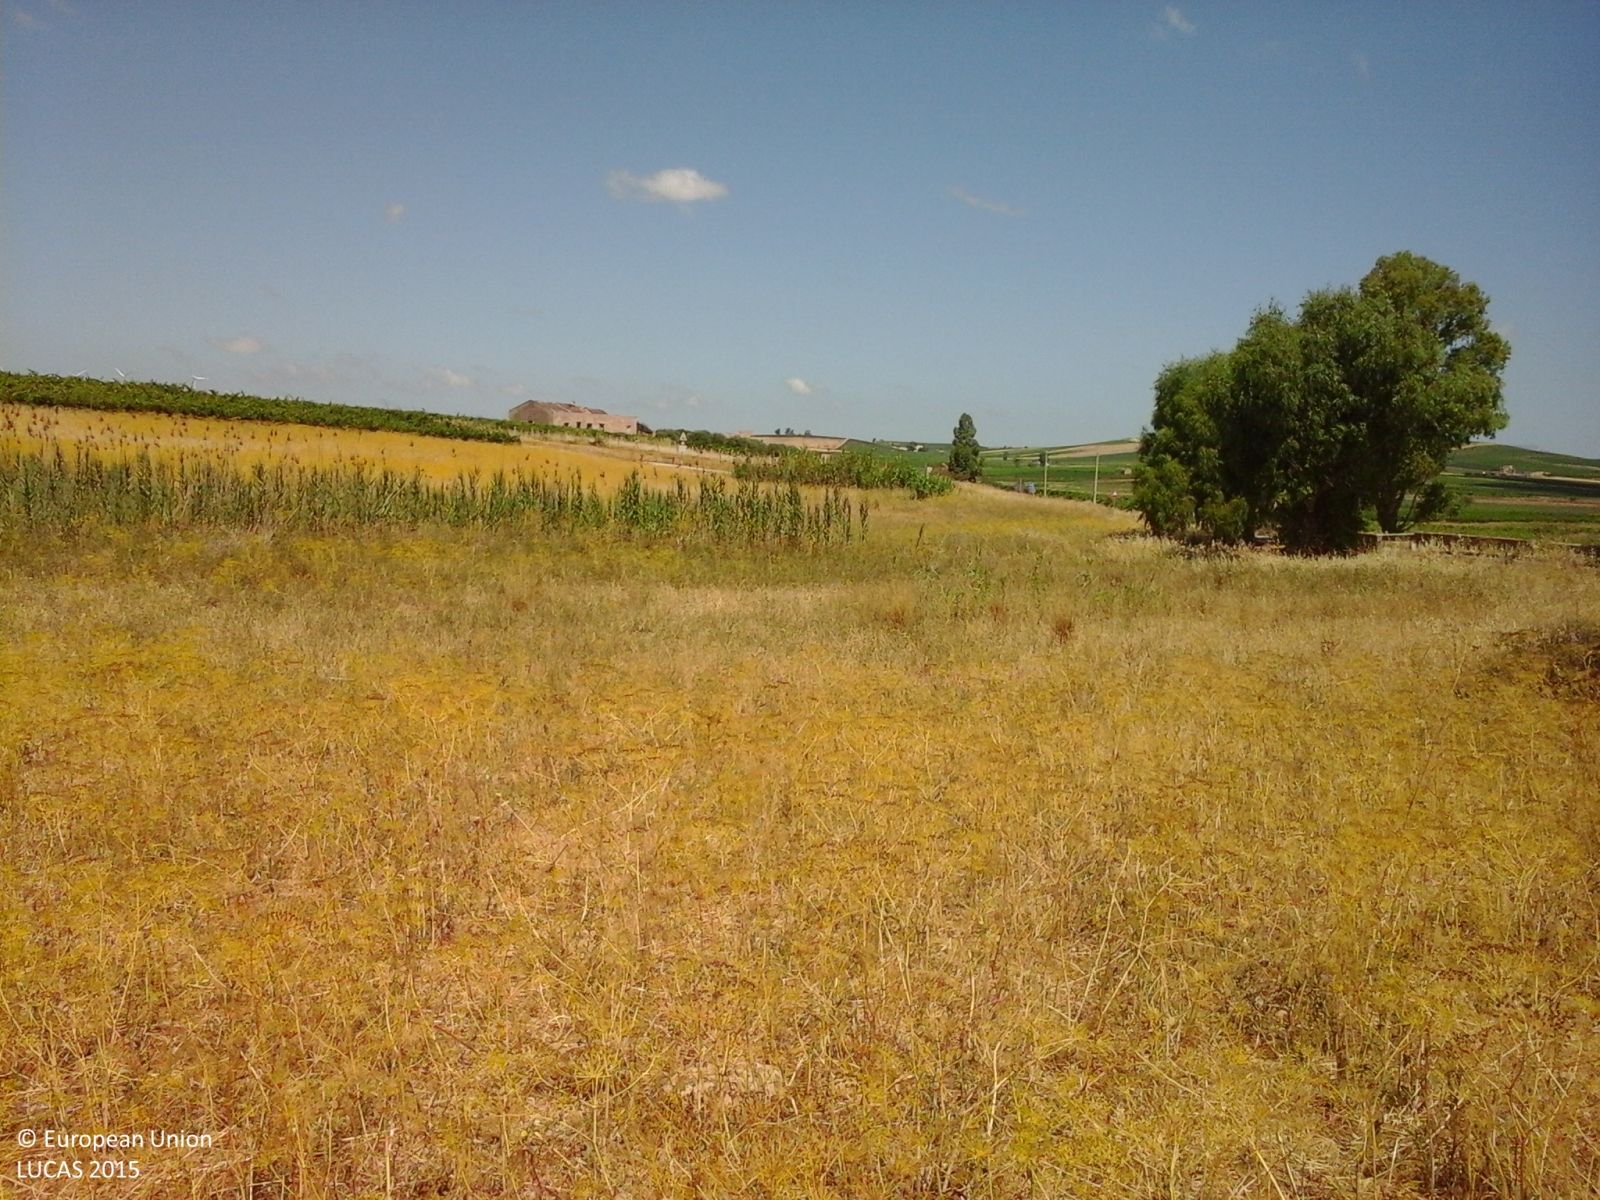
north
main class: Grassland
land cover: Spontaneously vegetated surfaces
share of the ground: > 75 %
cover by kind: herbaceous plants 100 %
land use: Agriculture (excluding fallow land and kitchen gardens)
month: June
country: IT
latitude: 37.7464
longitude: 12.6697
